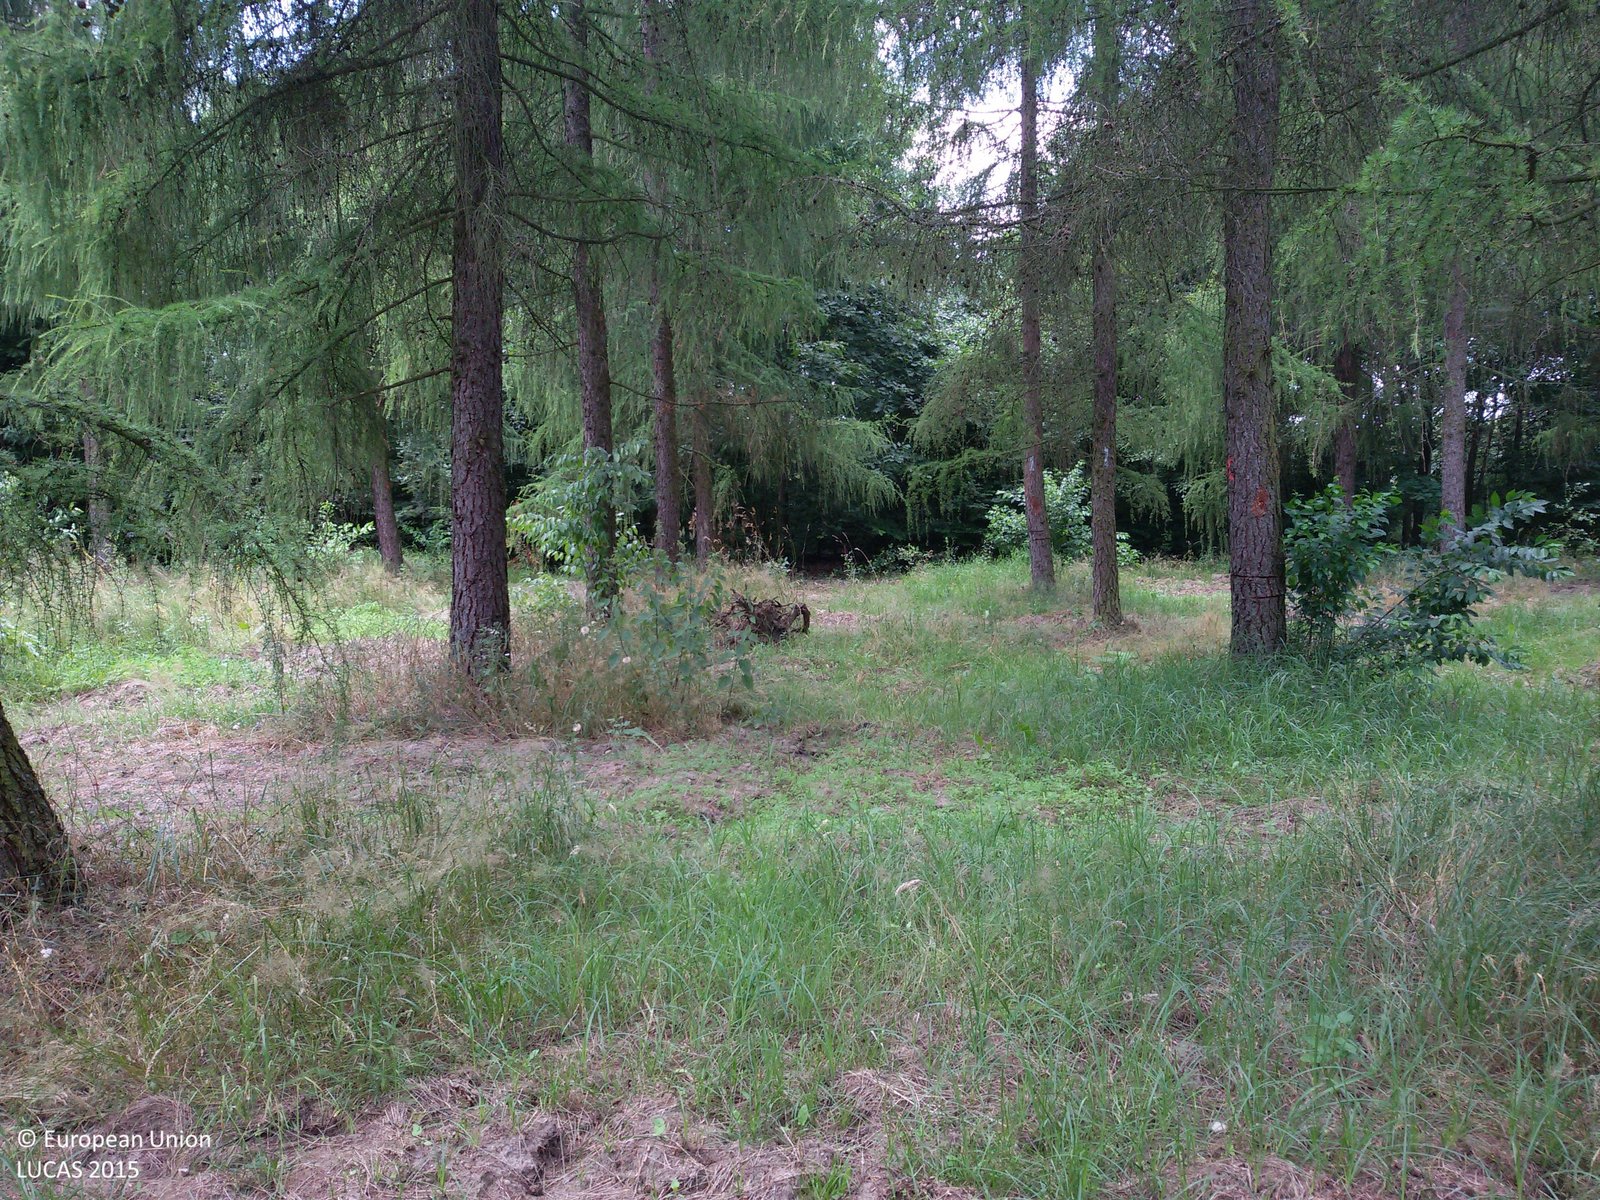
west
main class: Woodland
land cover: Other coniferous woodland
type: hemiboreal forest and nemoral coniferous forest and mixed broadleaved-coniferous forest
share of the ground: 50 - 75 %
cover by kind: coniferous forest trees 70 %, herbaceous plants 20 %, shrubs 5 %, unconsolidated bare surface 5 %
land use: Forestry
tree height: > 5 m
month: July
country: PL
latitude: 51.6972
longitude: 19.8260
